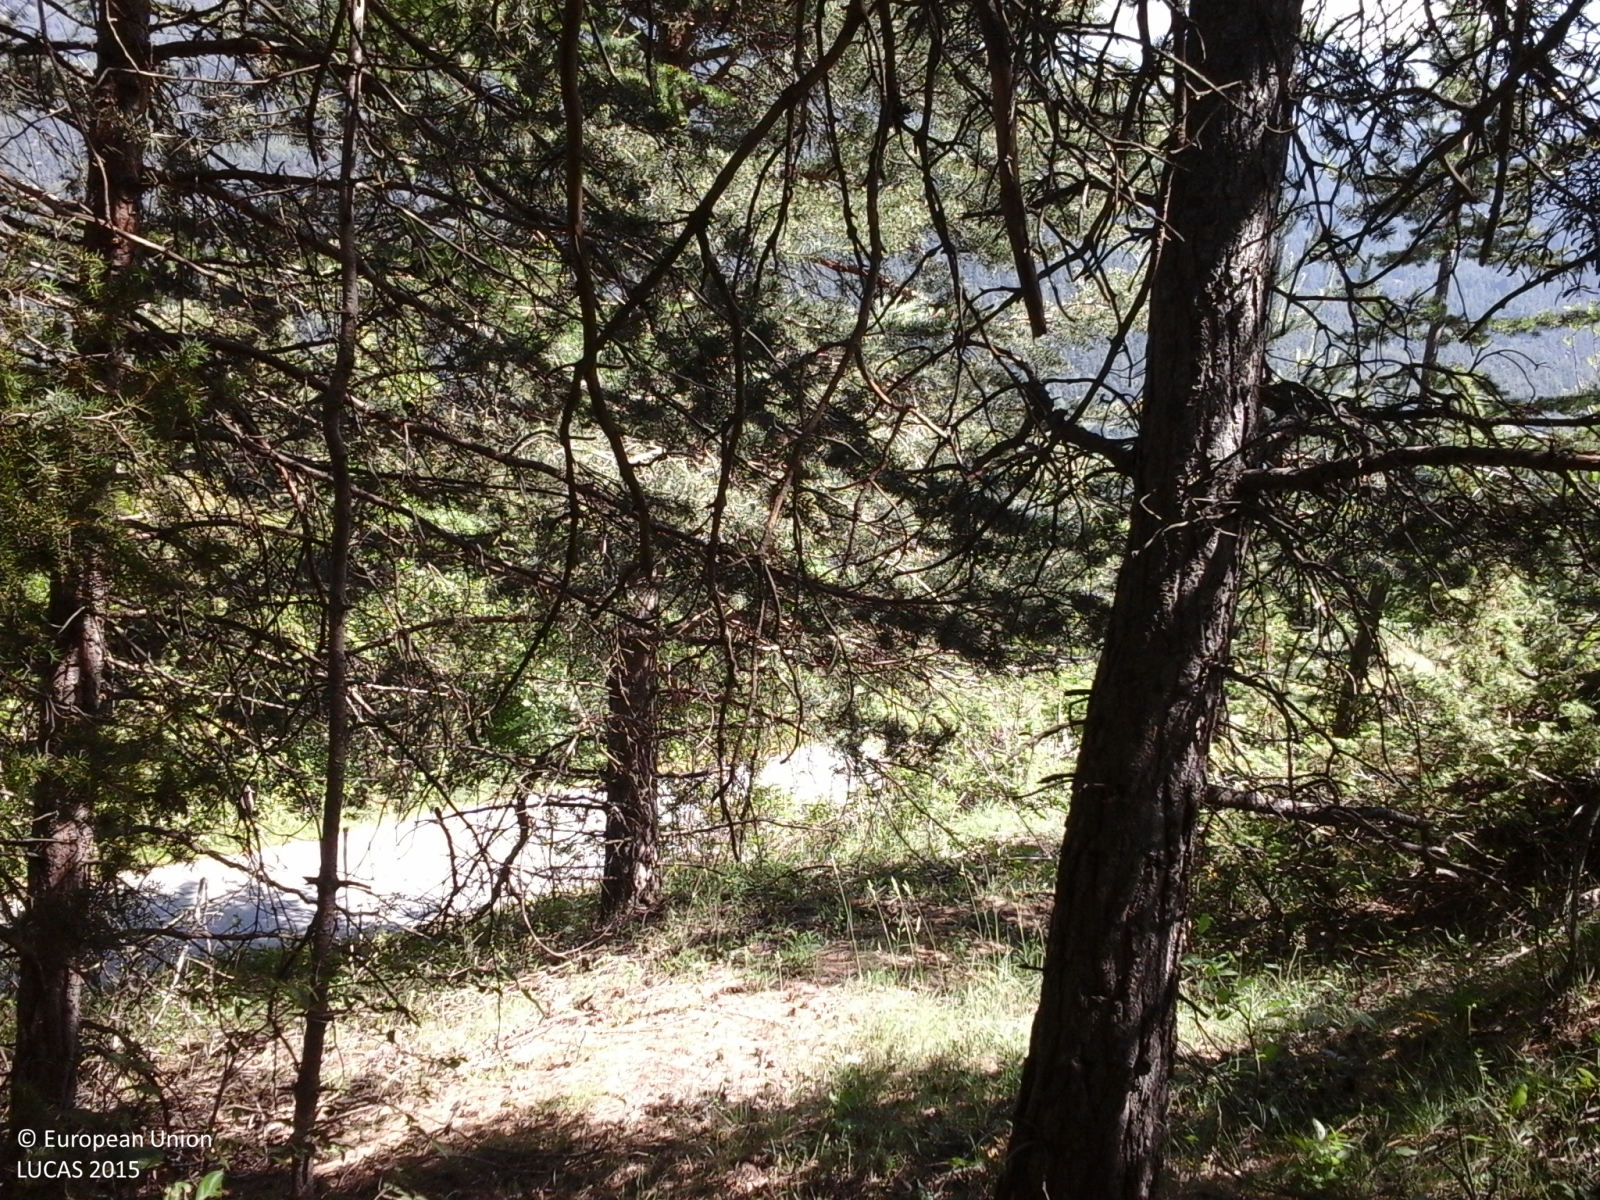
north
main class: Woodland
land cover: Pine dominated coniferous woodland
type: alpine coniferous forest
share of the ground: > 75 %
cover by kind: coniferous forest trees 100 %
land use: Semi-natural and natural areas not in use
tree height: > 5 m
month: June
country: IT
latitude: 45.0401
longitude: 6.7680
